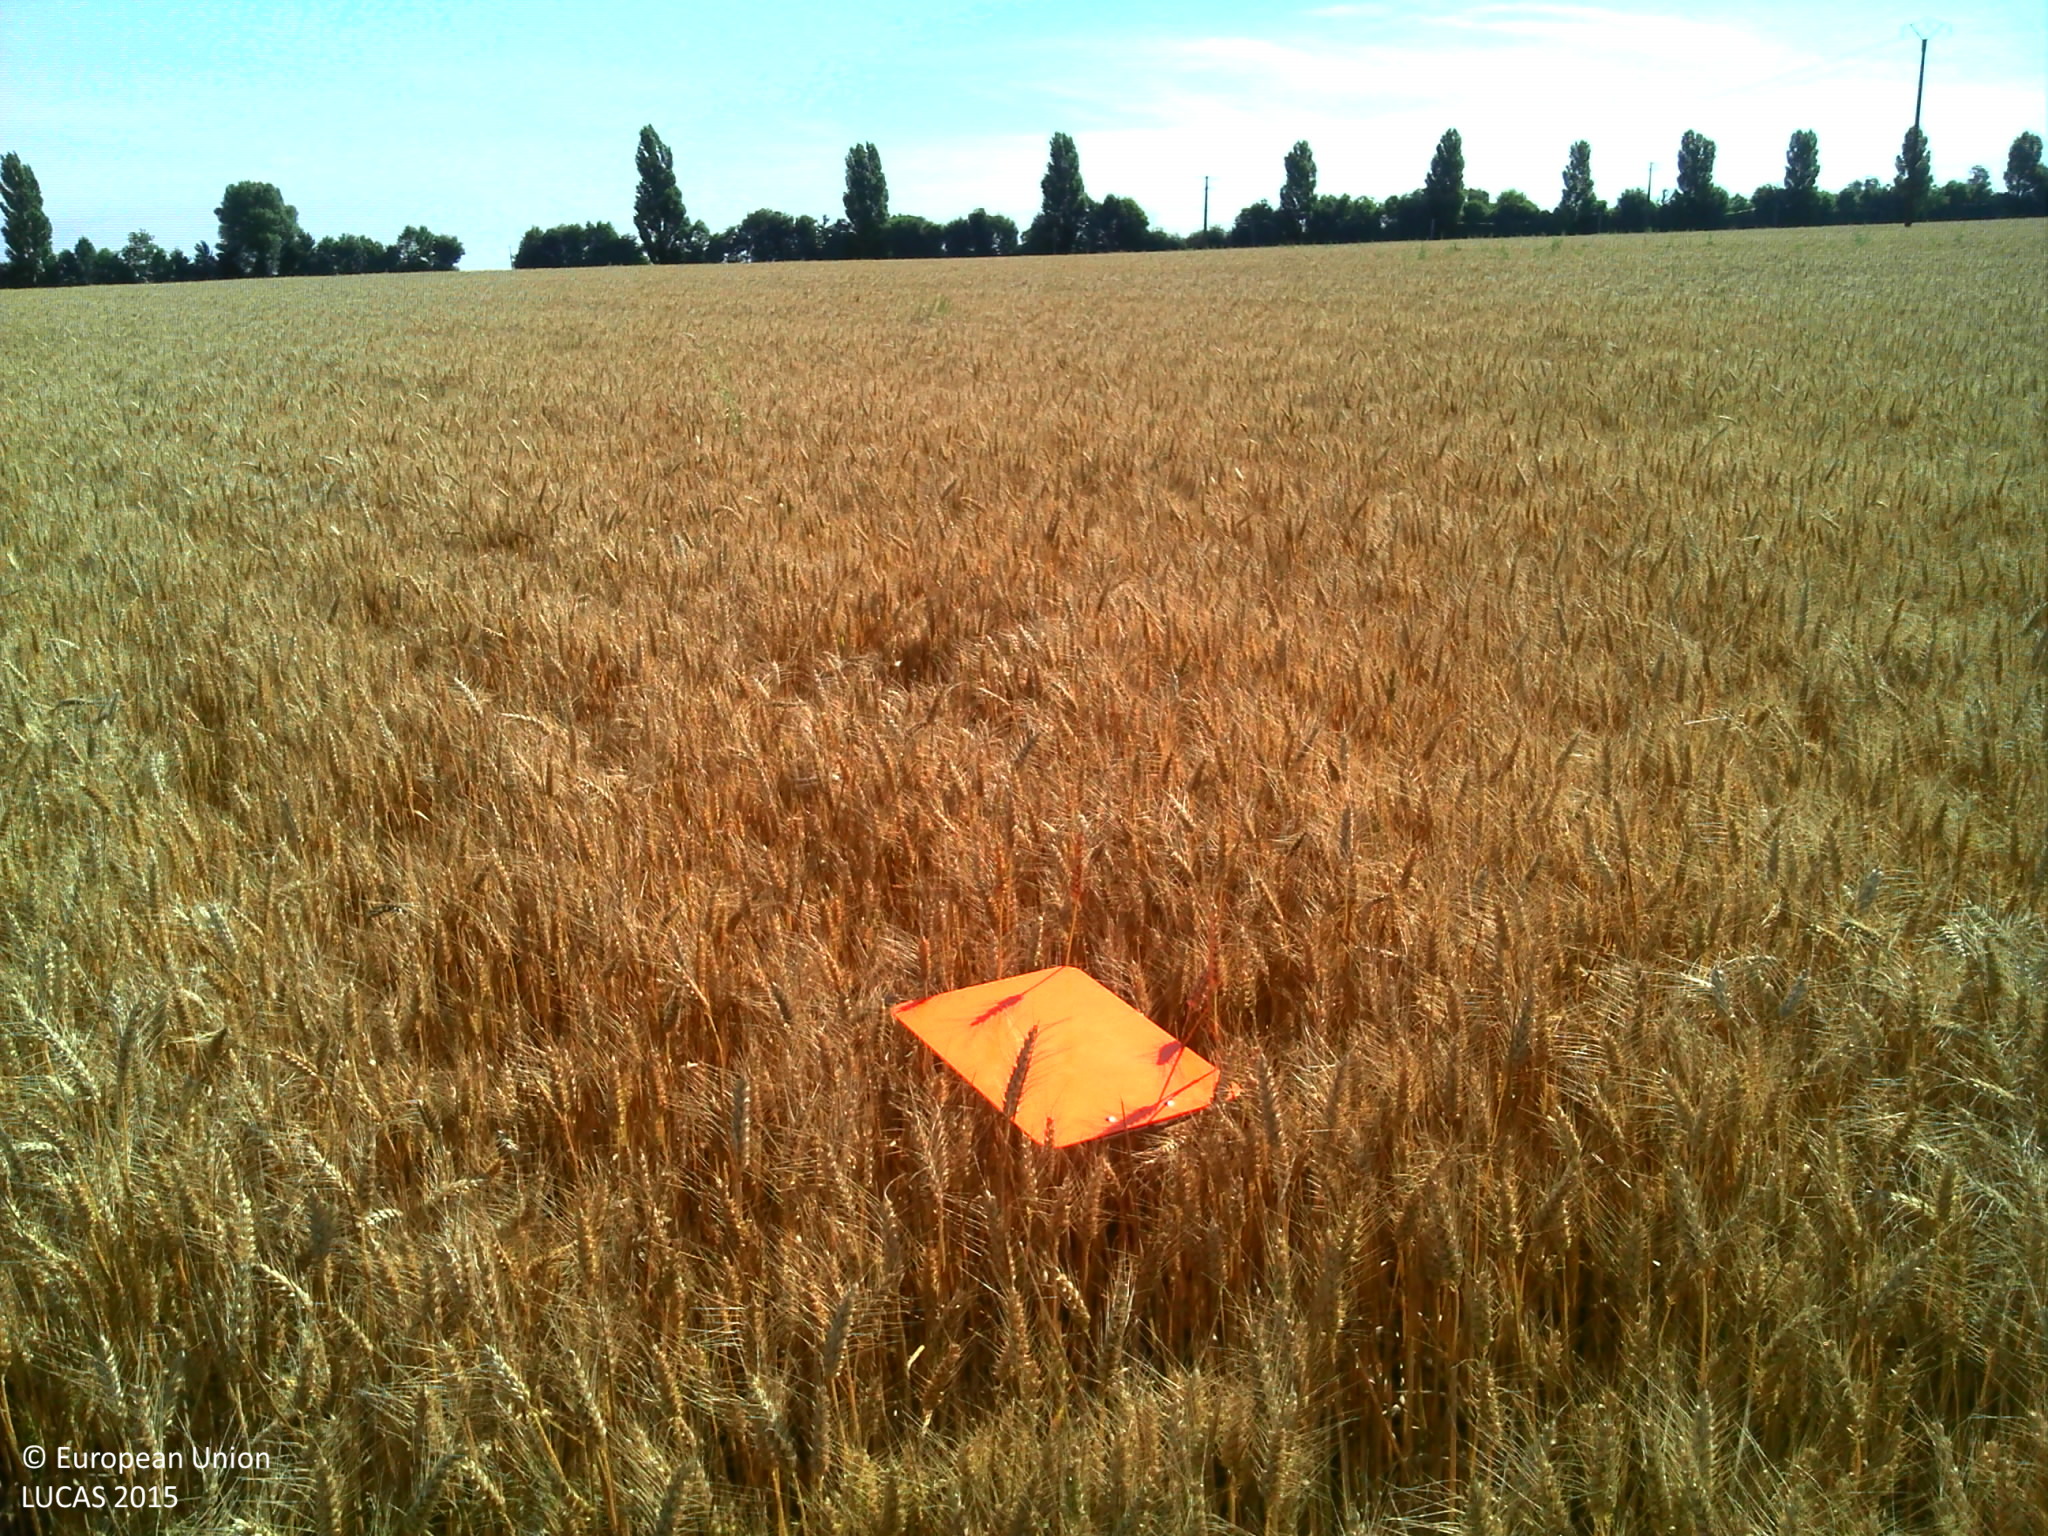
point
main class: Cropland
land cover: Durum wheat
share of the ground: > 75 %
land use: Agriculture (excluding fallow land and kitchen gardens)
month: June
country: FR
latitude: 45.8109
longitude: -0.7192
